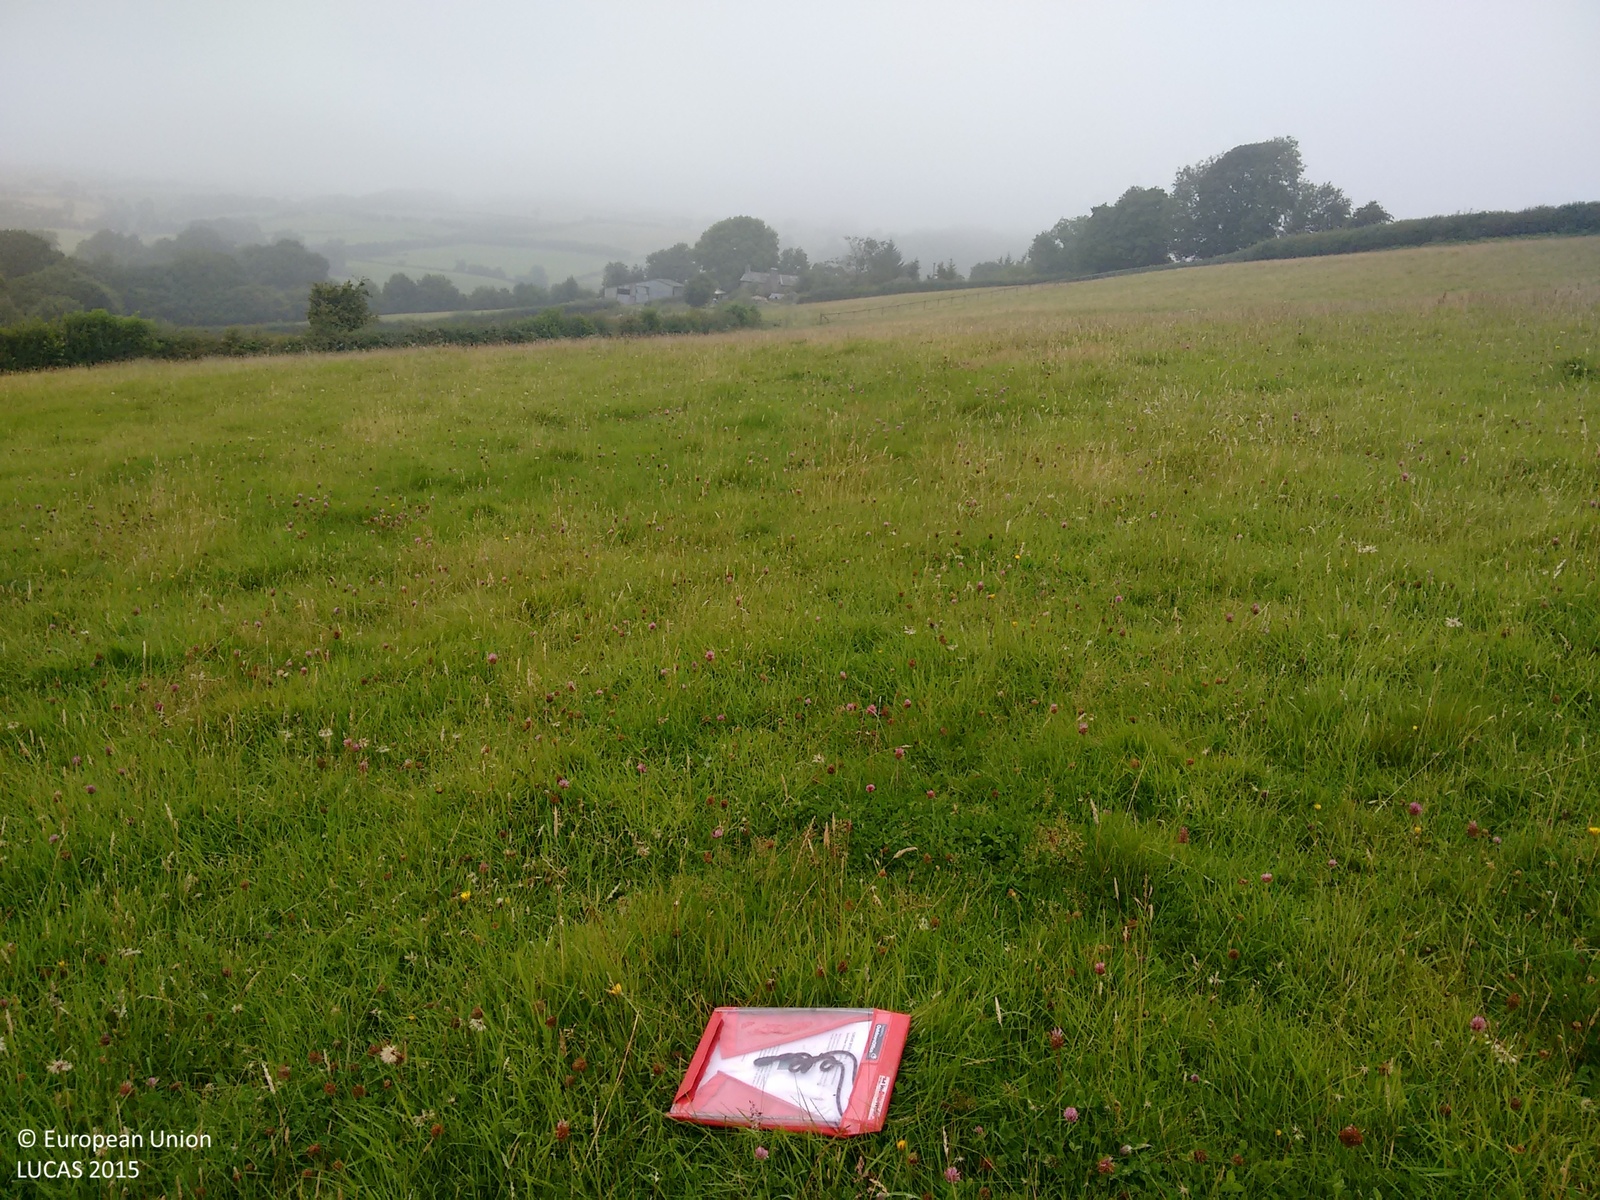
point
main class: Grassland
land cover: Grassland without tree/shrub cover
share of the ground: > 75 %
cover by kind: herbaceous plants 100 %
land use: Agriculture (excluding fallow land and kitchen gardens)
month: September
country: GB
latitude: 52.1335
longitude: -3.1533
